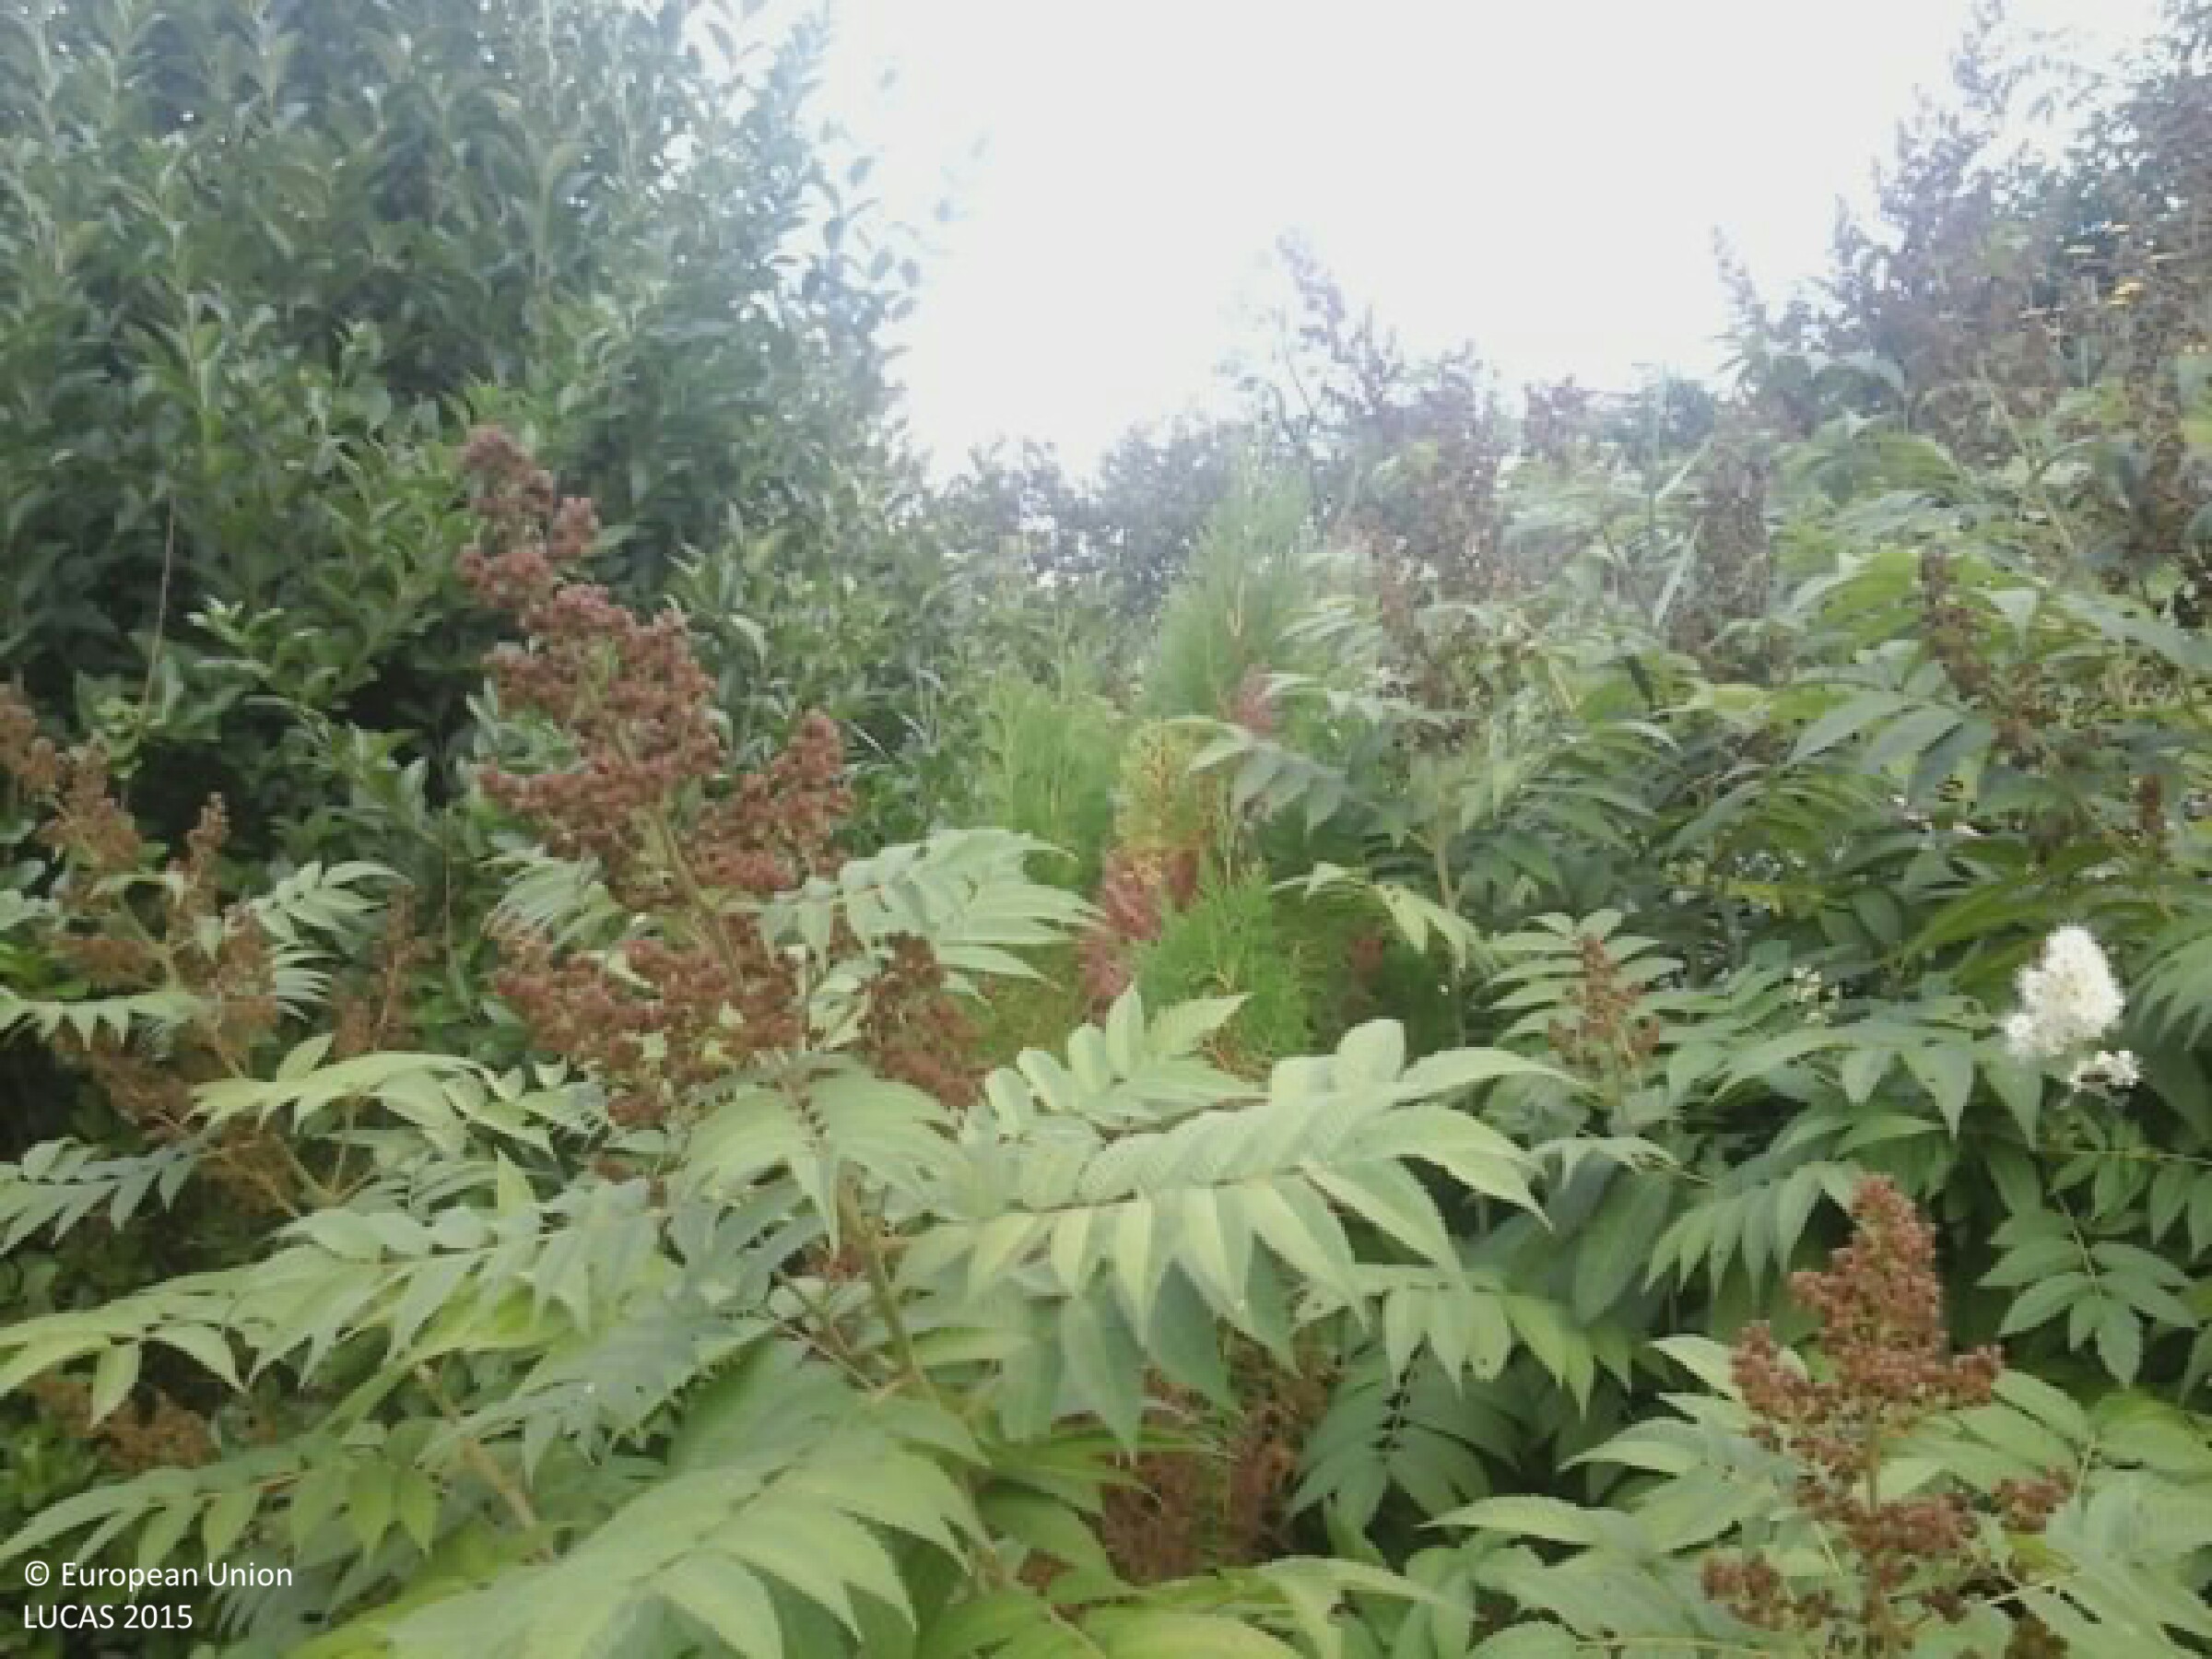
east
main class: Cropland
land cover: Floriculture and ornamental plants
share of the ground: > 75 %
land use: Kitchen garden
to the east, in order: Floriculture and ornamental plants; Artificial constructions in urban areas
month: August
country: HU
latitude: 46.2359
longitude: 18.1901
